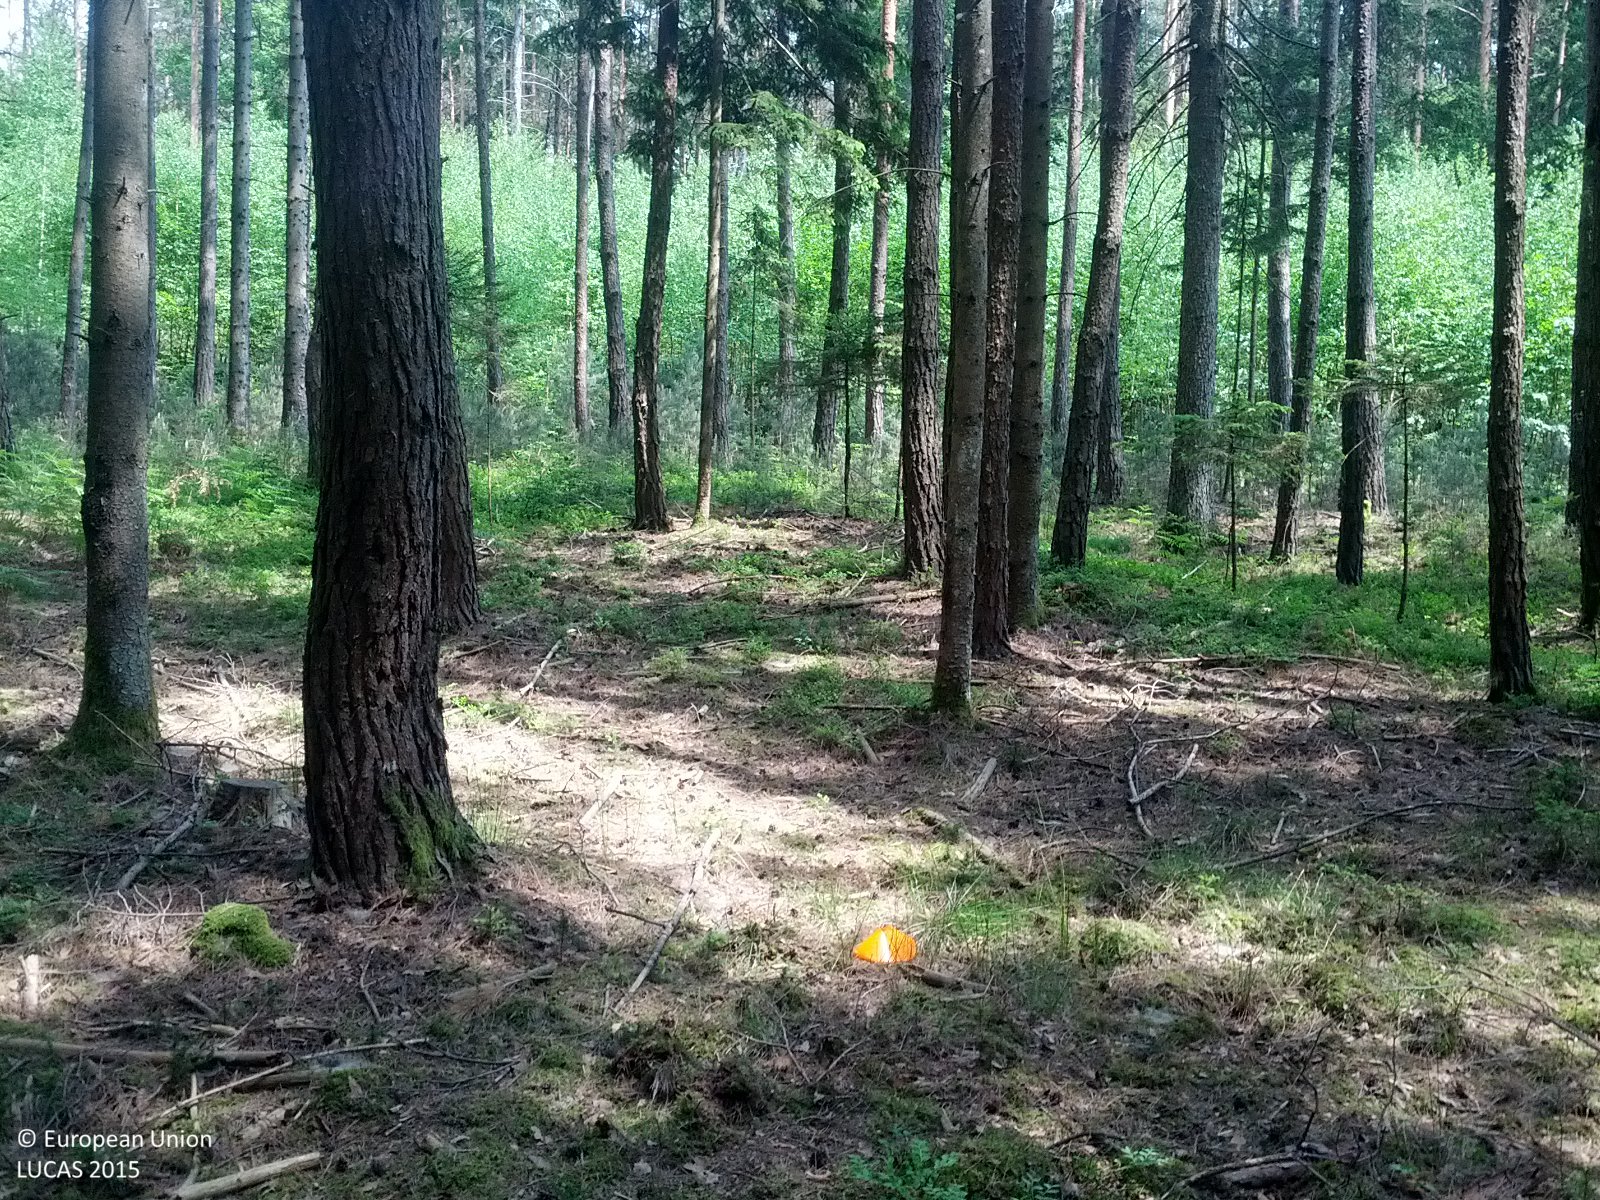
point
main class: Woodland
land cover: Pine dominated coniferous woodland
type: boreal forest
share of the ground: > 75 %
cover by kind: coniferous forest trees 80 %, lichens and mosses 10 %, shrubs 5 %, herbaceous plants 5 %
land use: Forestry
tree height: > 5 m
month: May
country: AT
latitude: 47.3311
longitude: 16.1290
